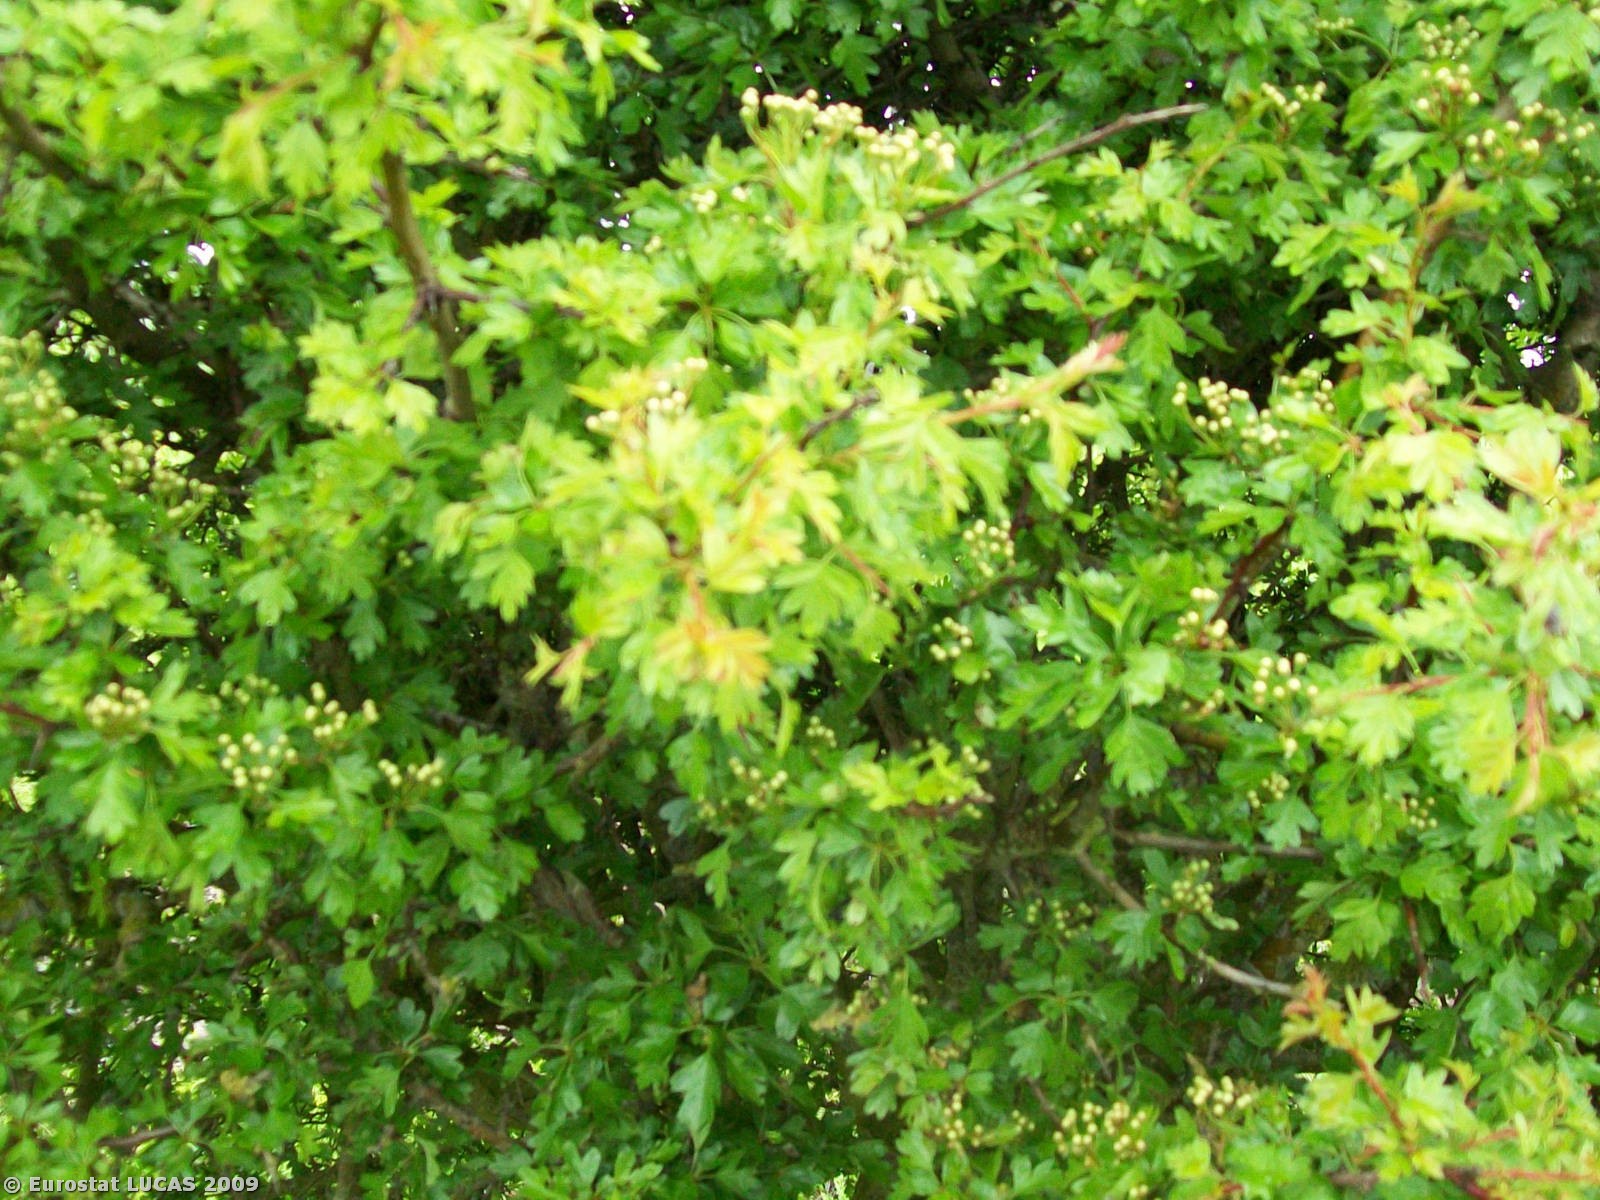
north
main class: Cropland
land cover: Barley
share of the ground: < 10 %
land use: Agriculture (excluding fallow land and kitchen gardens)
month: May
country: GB
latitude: 53.7660
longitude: -2.8910
